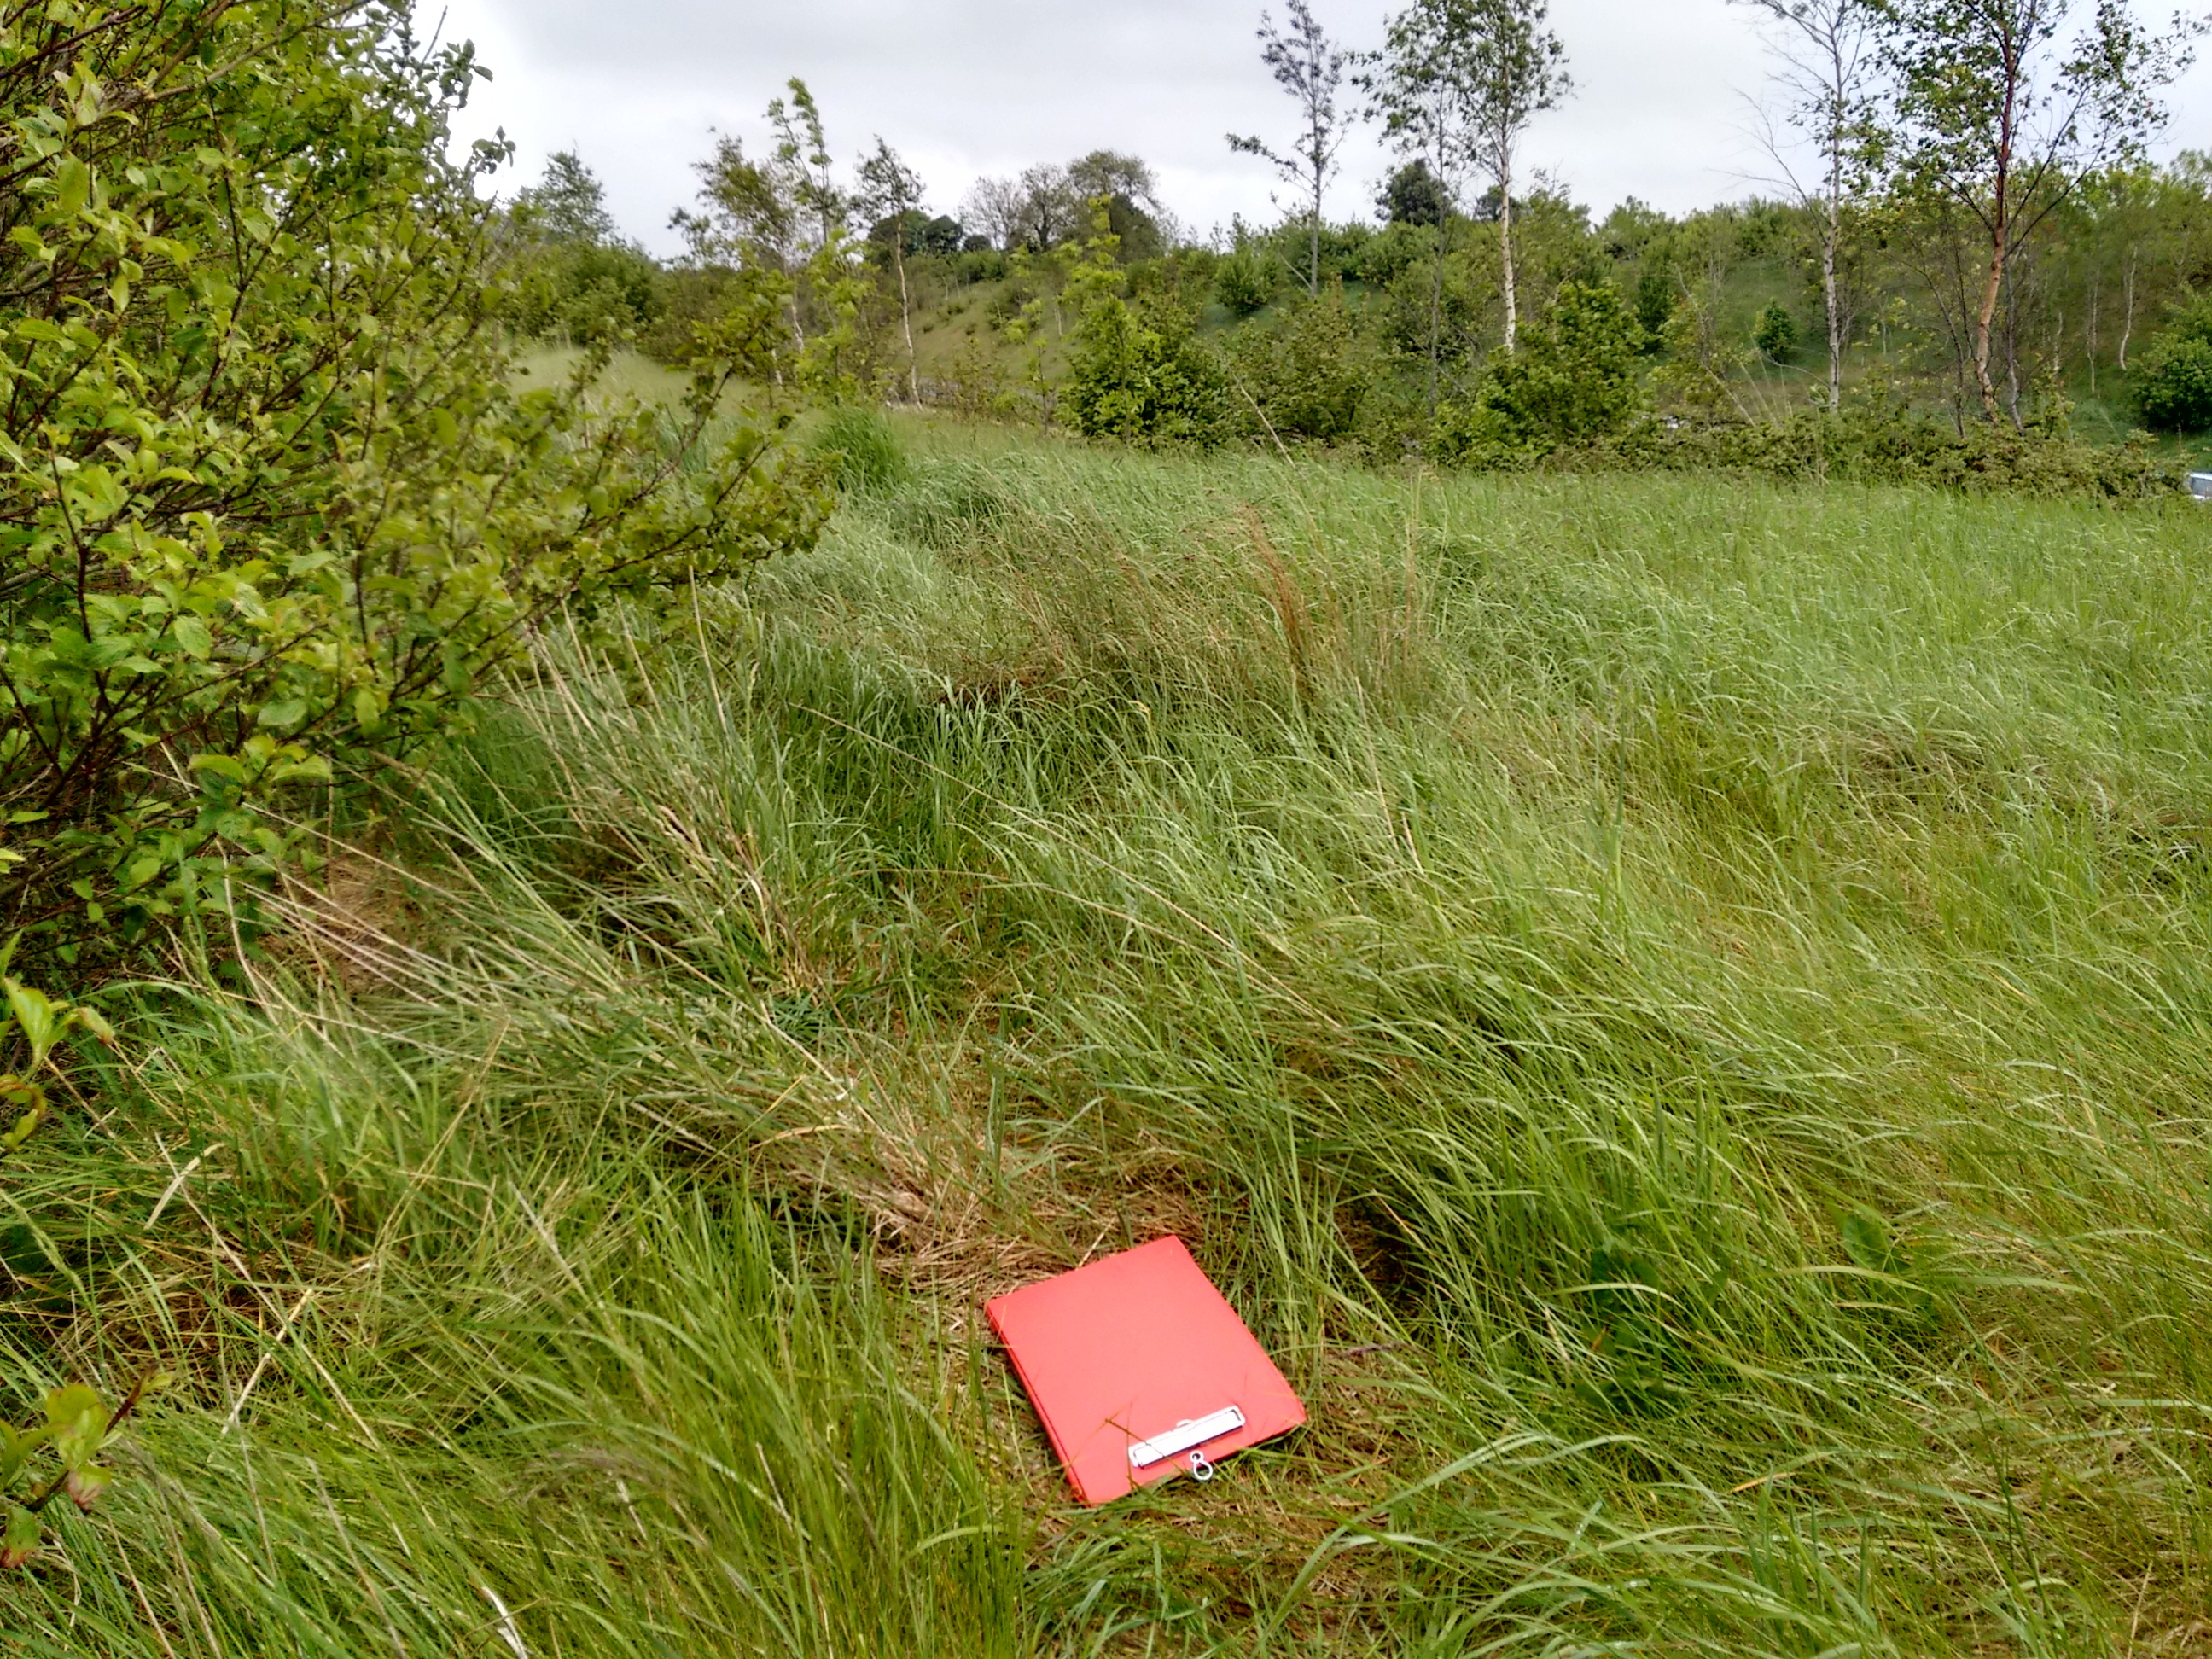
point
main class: Grassland
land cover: Grassland with sparse tree/shrub cover
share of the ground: > 75 %
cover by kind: herbaceous plants 85 %, shrubs 10 %, broadleaved forest trees 5 %
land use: Road transport
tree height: < 5 m
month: May
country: IE
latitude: 53.4268
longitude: -6.9507
